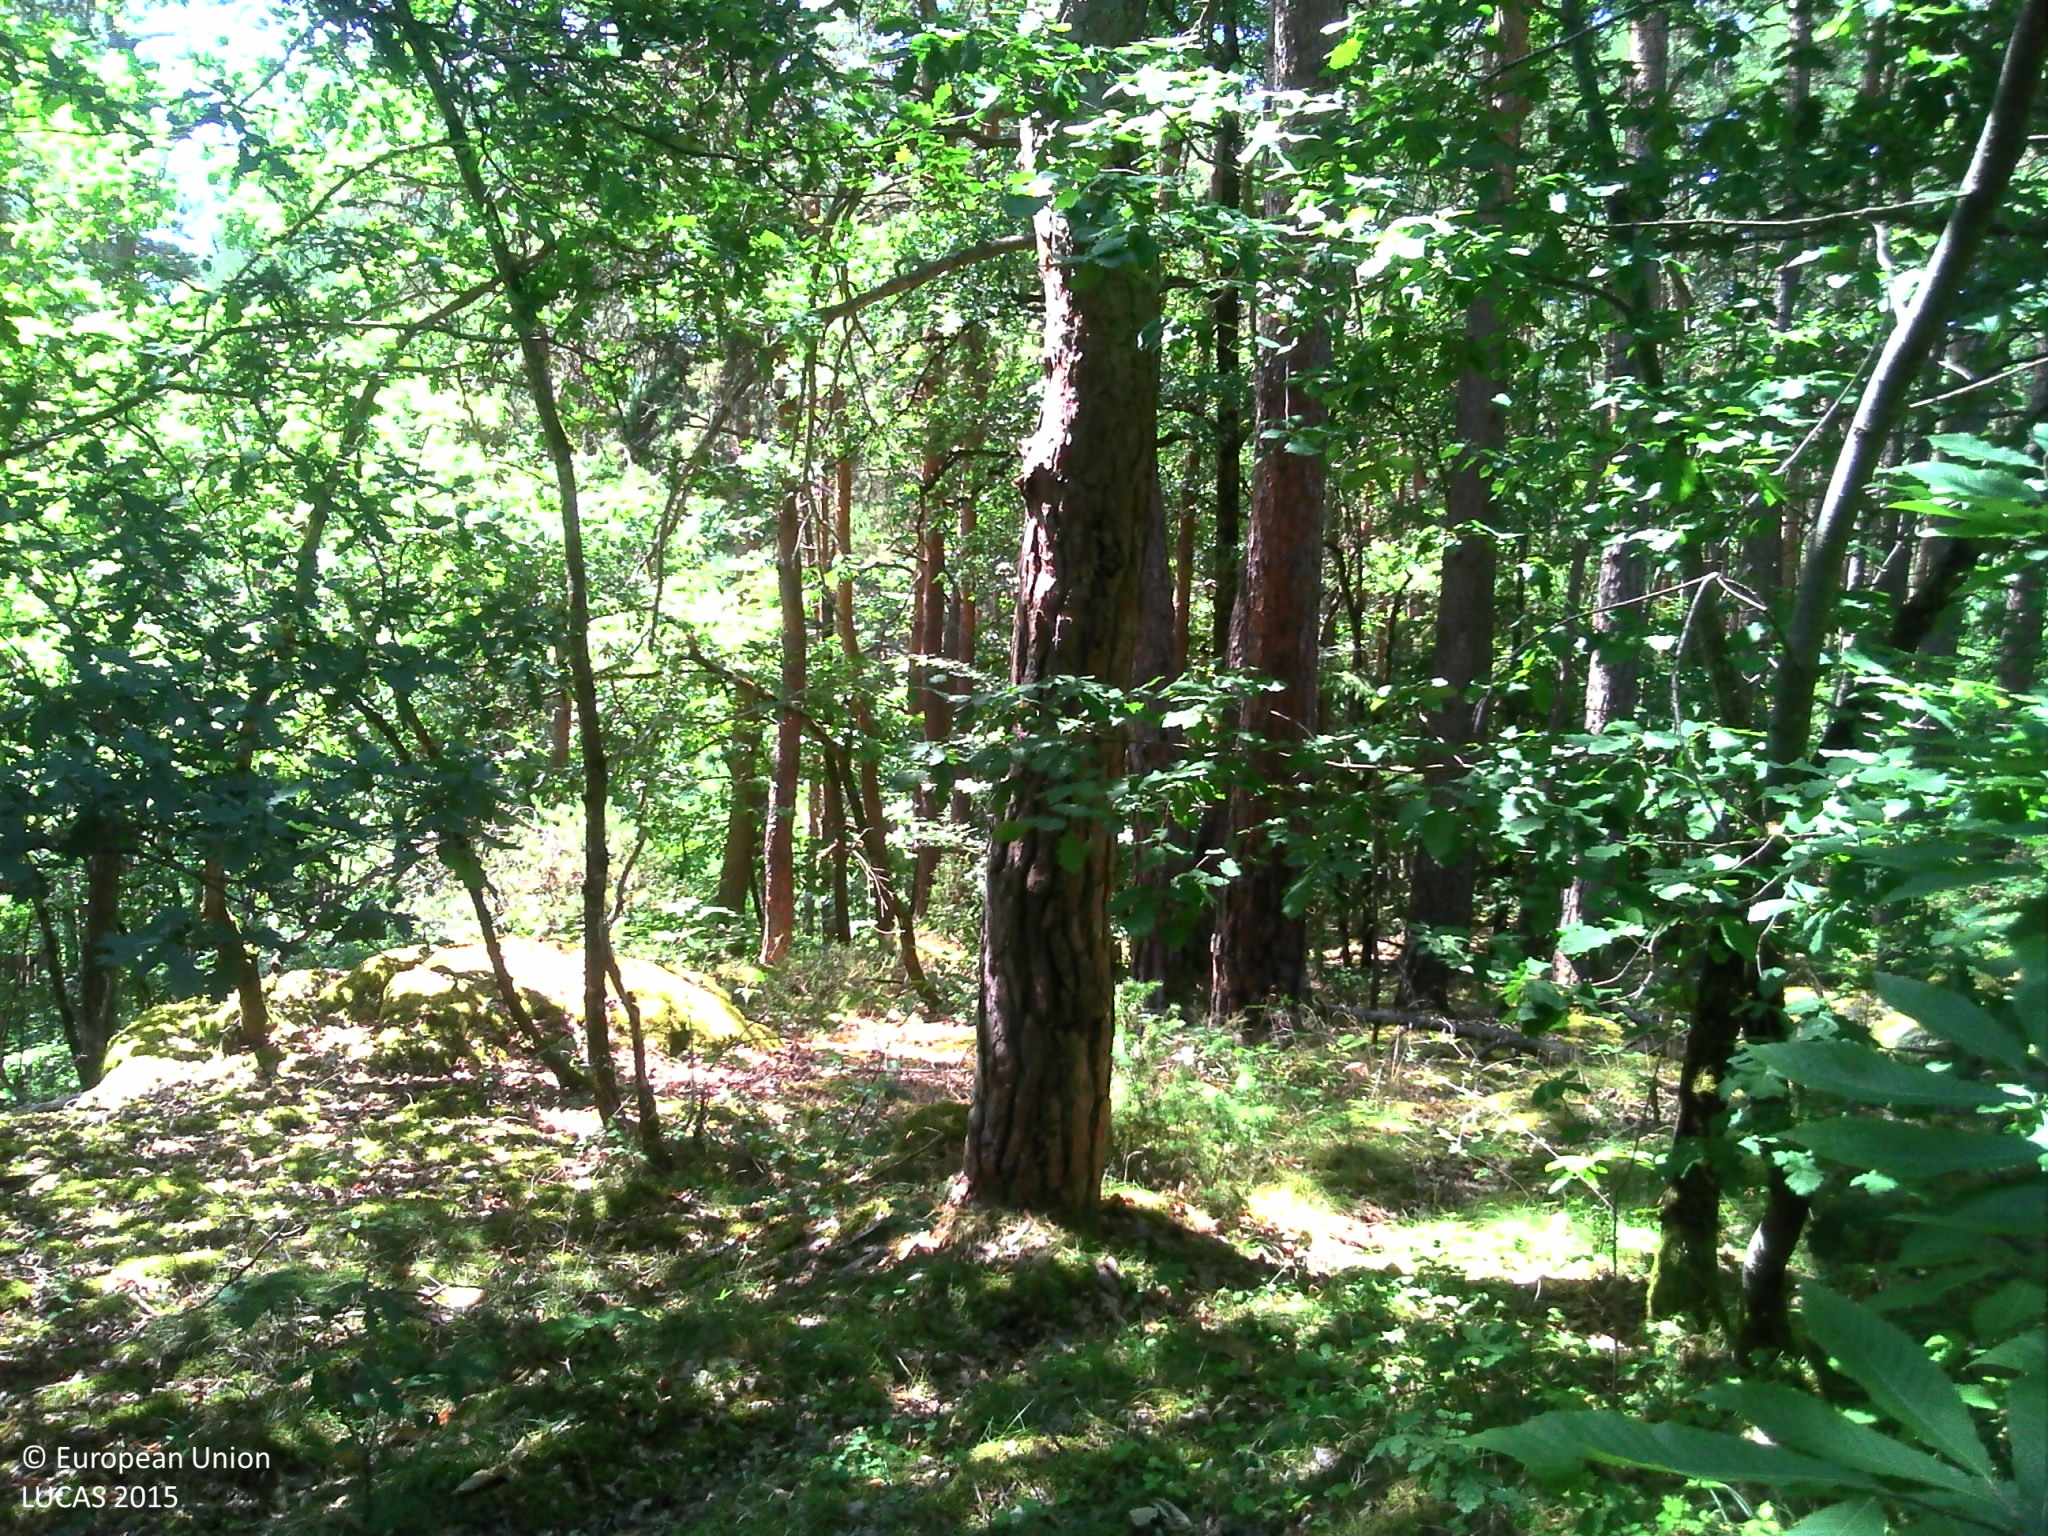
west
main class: Woodland
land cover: Pine dominated mixed woodland
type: hemiboreal forest and nemoral coniferous forest and mixed broadleaved-coniferous forest
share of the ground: > 75 %
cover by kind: coniferous forest trees 75 %, broadleaved forest trees 25 %
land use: Forestry
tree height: > 5 m
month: July
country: FR
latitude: 45.3195
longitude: 3.4580
